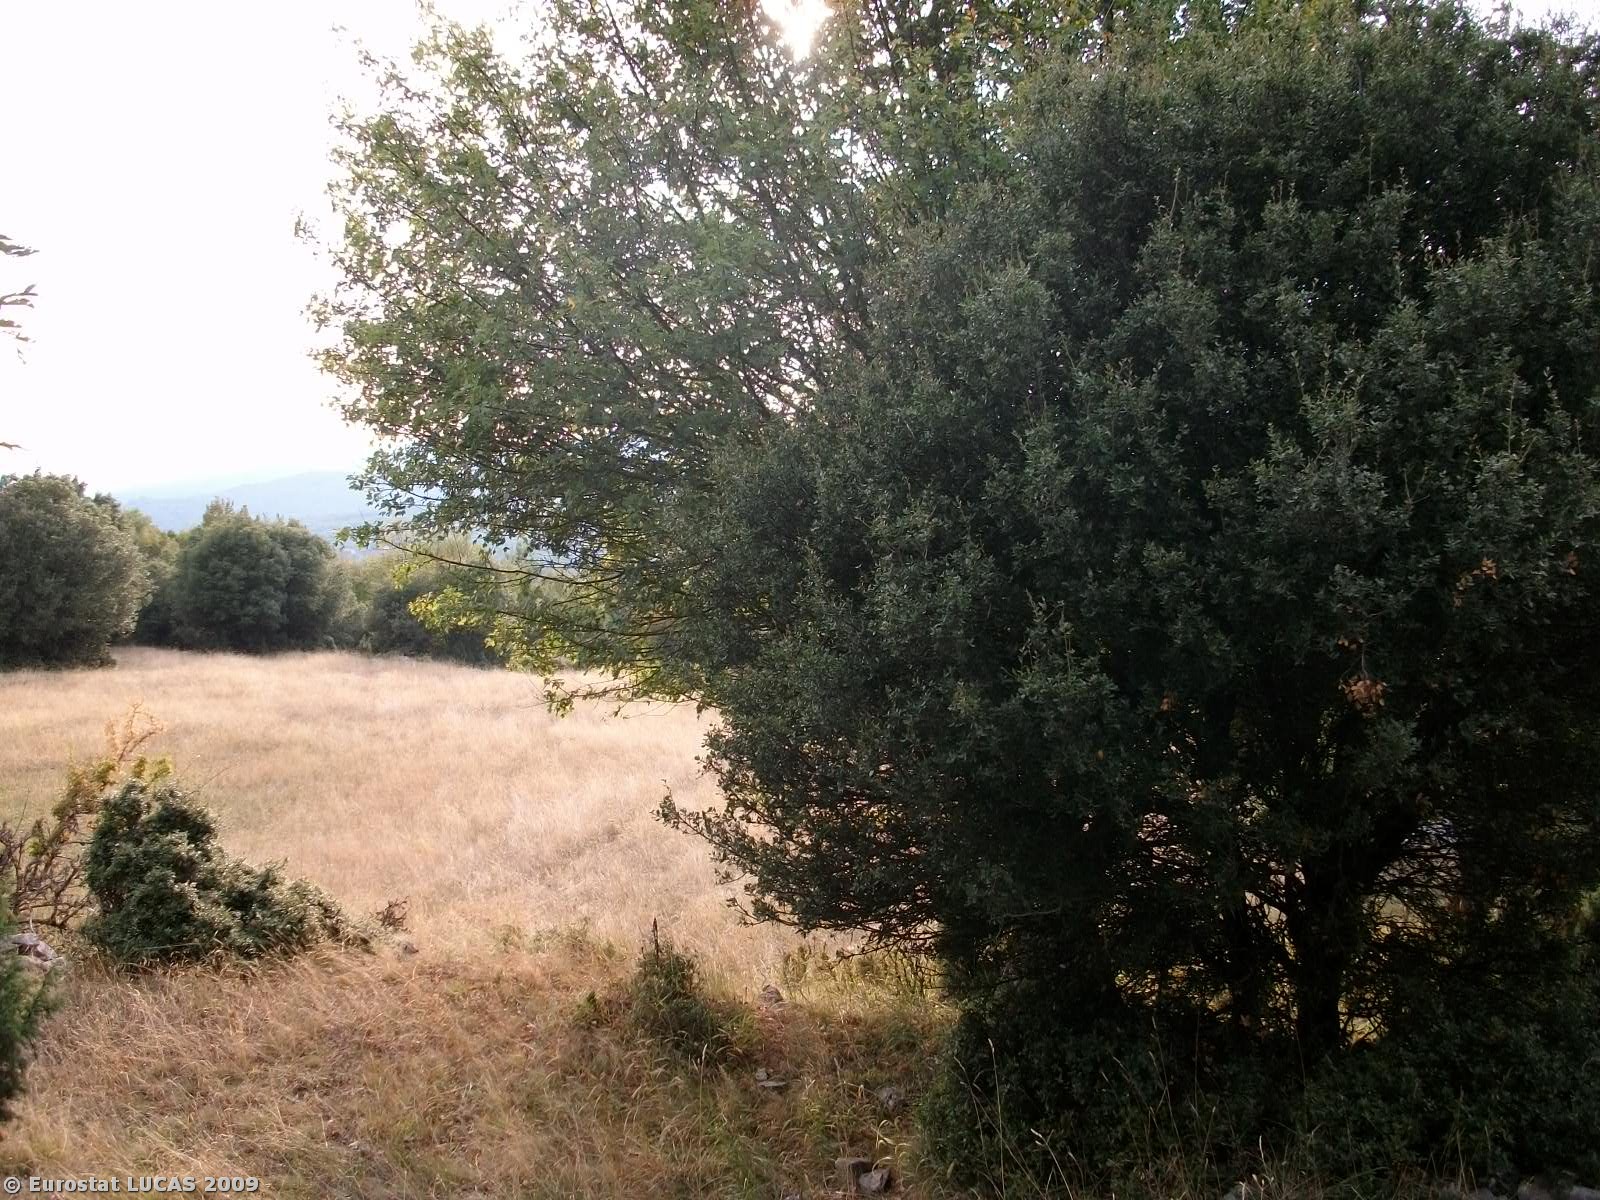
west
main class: Woodland
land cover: Broadleaved woodland
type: broadleaved evergreen forest
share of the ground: 50 - 75 %
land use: Forestry
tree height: > 5 m
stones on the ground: 25 - 50 %
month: September
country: GR
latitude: 41.1160
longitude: 24.4562
